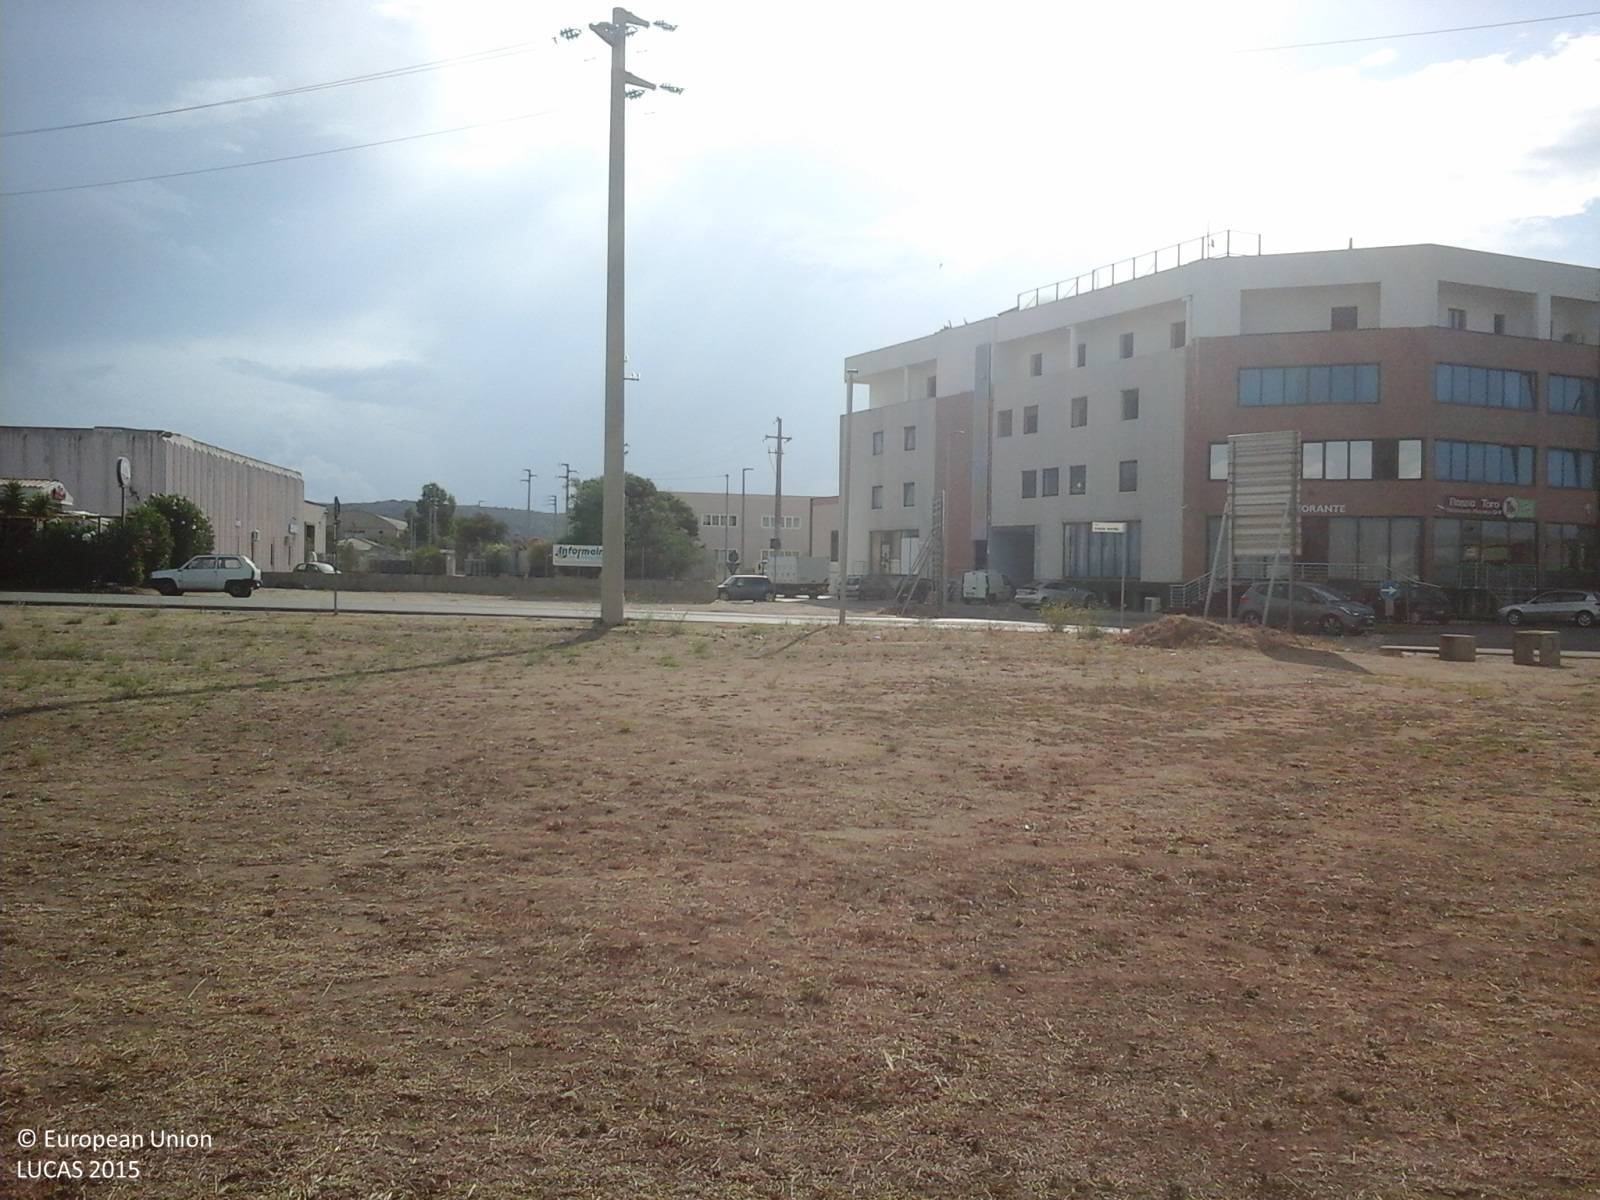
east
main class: Grassland
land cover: Grassland without tree/shrub cover
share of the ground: > 75 %
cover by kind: herbaceous plants 90 %, unconsolidated bare surface 10 %
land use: Commerce
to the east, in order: Grassland without tree/shrub cover; Artificial constructions in urban areas
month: August
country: IT
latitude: 40.9357
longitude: 9.5153
